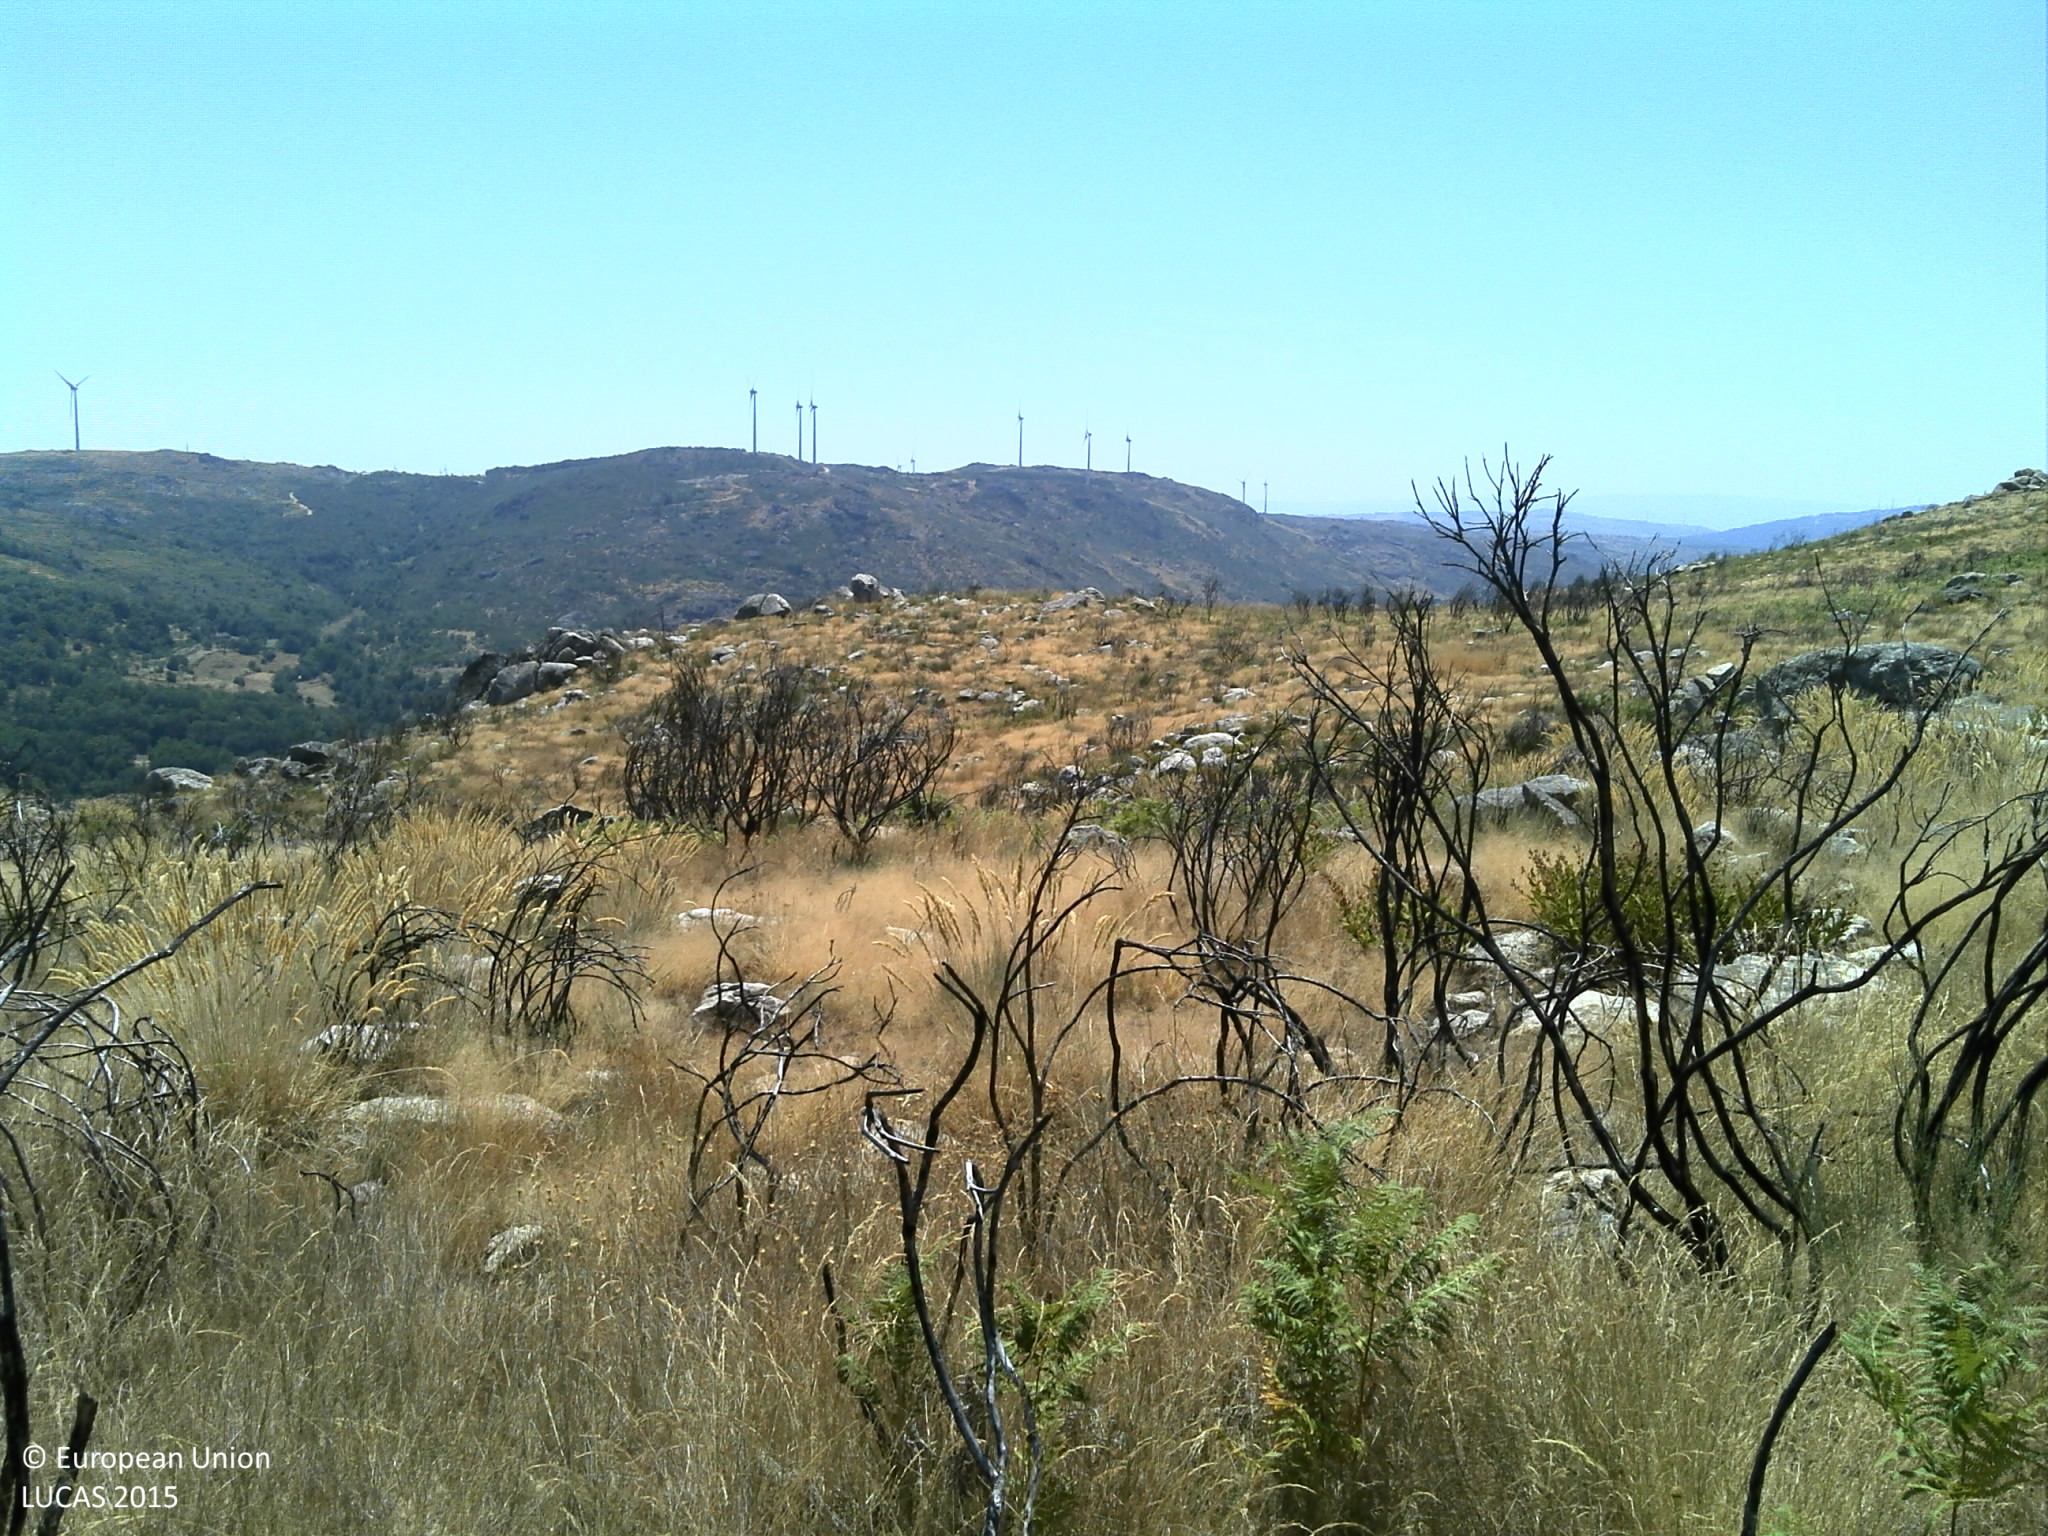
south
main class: Grassland
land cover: Grassland without tree/shrub cover
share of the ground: 50 - 75 %
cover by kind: herbaceous plants 60 %, consolidated bare surface 20 %, unconsolidated bare surface 15 %, shrubs 5 %
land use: Semi-natural and natural areas not in use
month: July
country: PT
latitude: 40.8754
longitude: -7.4038
